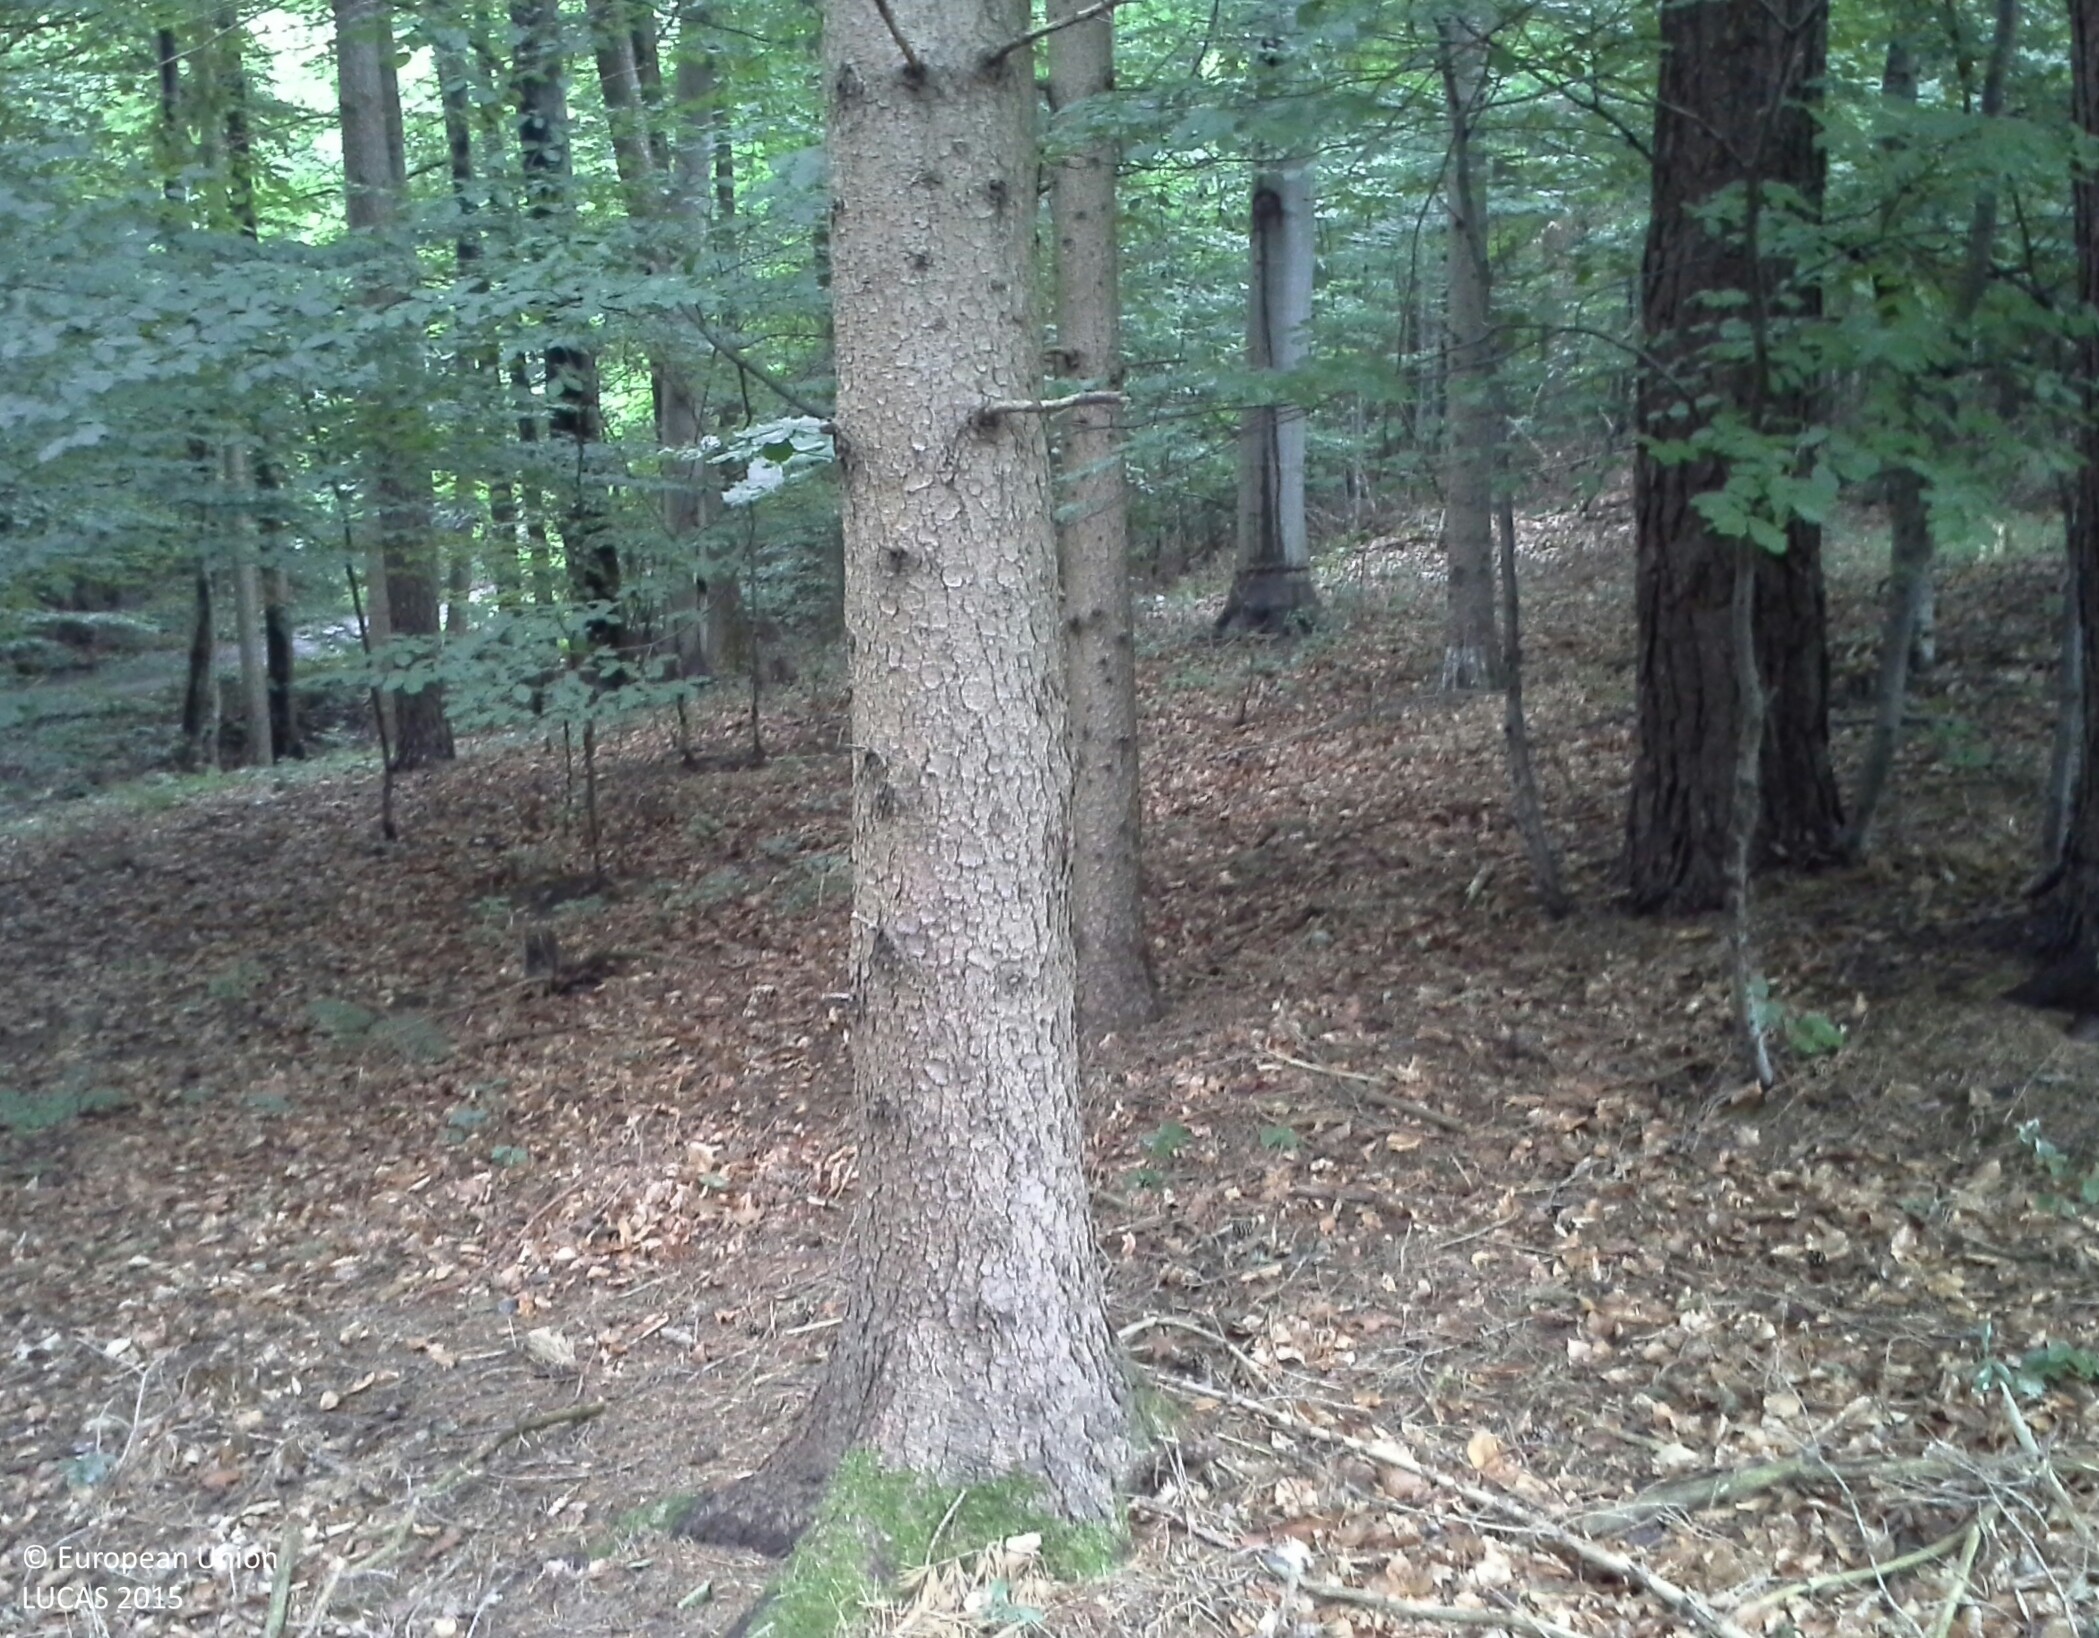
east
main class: Woodland
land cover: Spruce dominated mixed woodland
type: beech forest
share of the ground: > 75 %
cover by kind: coniferous forest trees 50 %, broadleaved forest trees 35 %, consolidated bare surface 10 %, herbaceous plants 5 %
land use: Forestry
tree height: > 5 m
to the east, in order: Spruce dominated mixed woodland; Broadleaved woodland; Rivers and streams; Broadleaved woodland; Paved roads, cycling and walking lanes; Broadleaved woodland; Shruby margins; Tracks; Grassland without tree/shrub cover
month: July
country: AT
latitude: 48.0462
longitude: 14.8164
